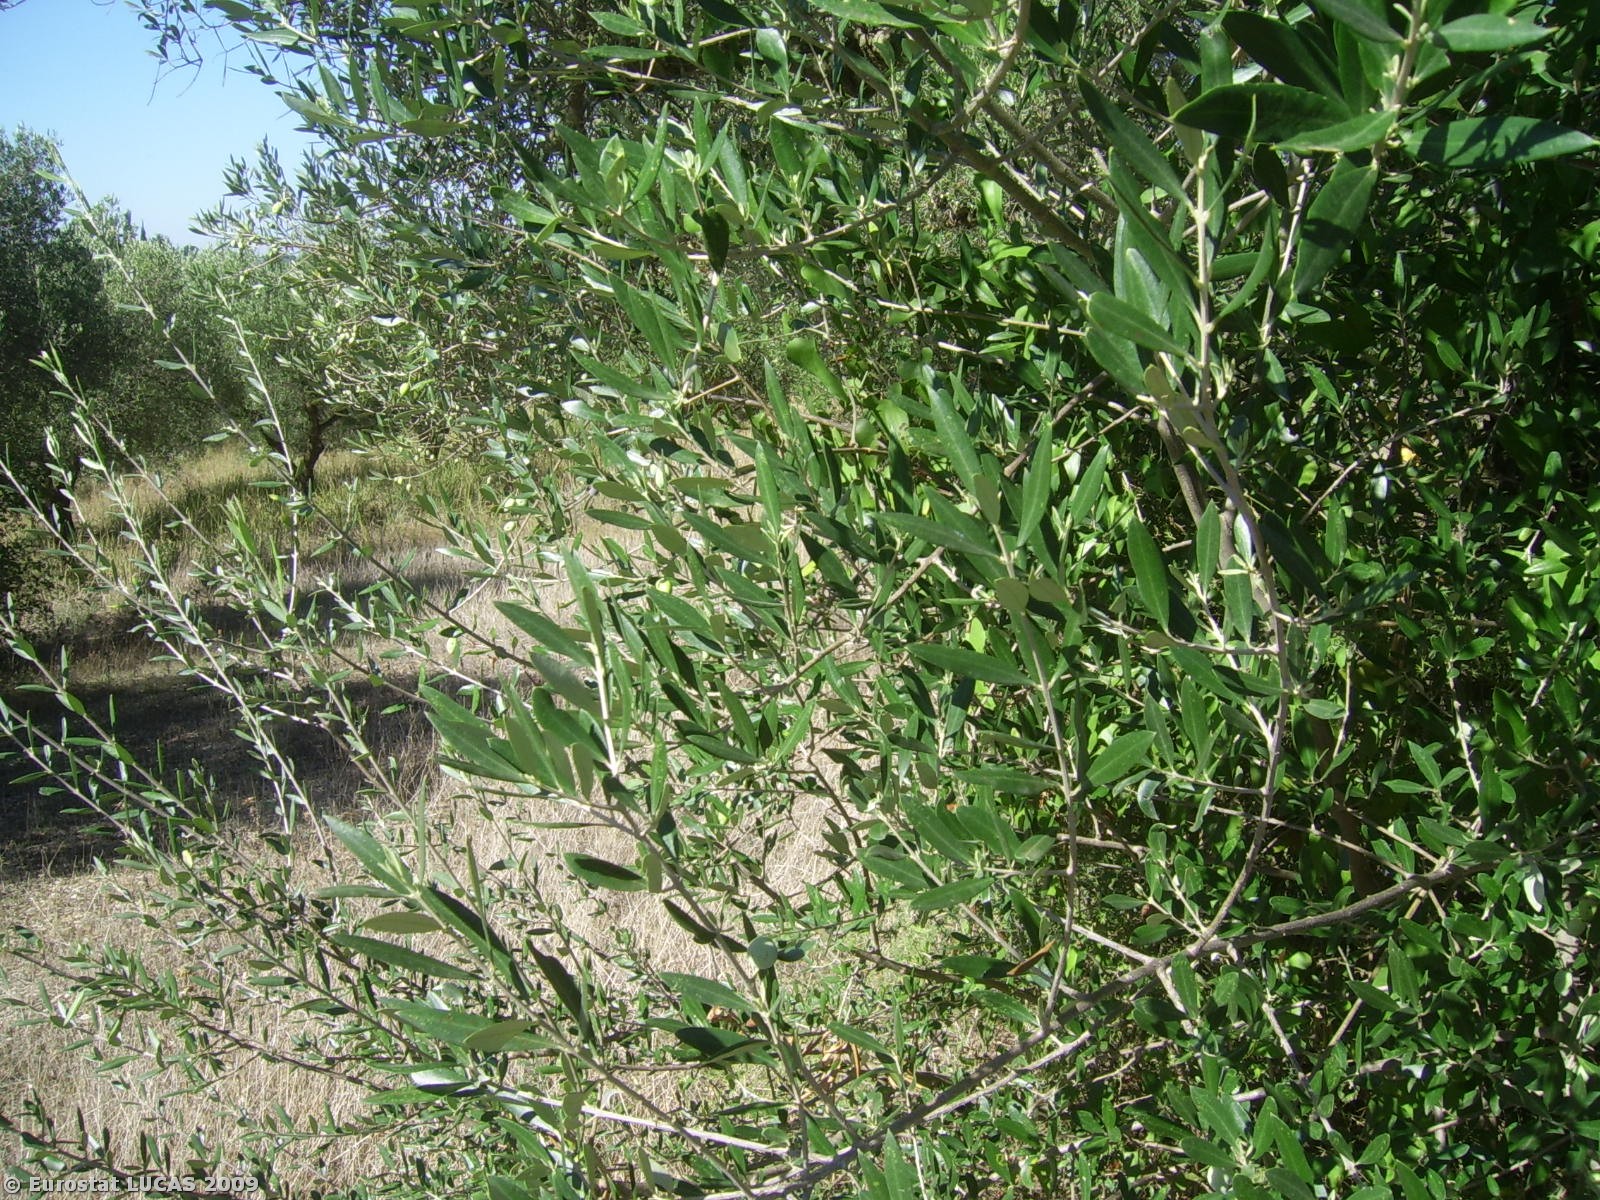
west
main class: Cropland
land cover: Olive groves
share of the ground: 50 - 75 %
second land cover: Grassland with sparse tree/shrub cover
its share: 50 - 75 %
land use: Agriculture (excluding fallow land and kitchen gardens)
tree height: > 5 m
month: October
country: GR
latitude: 37.9892
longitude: 21.4285
